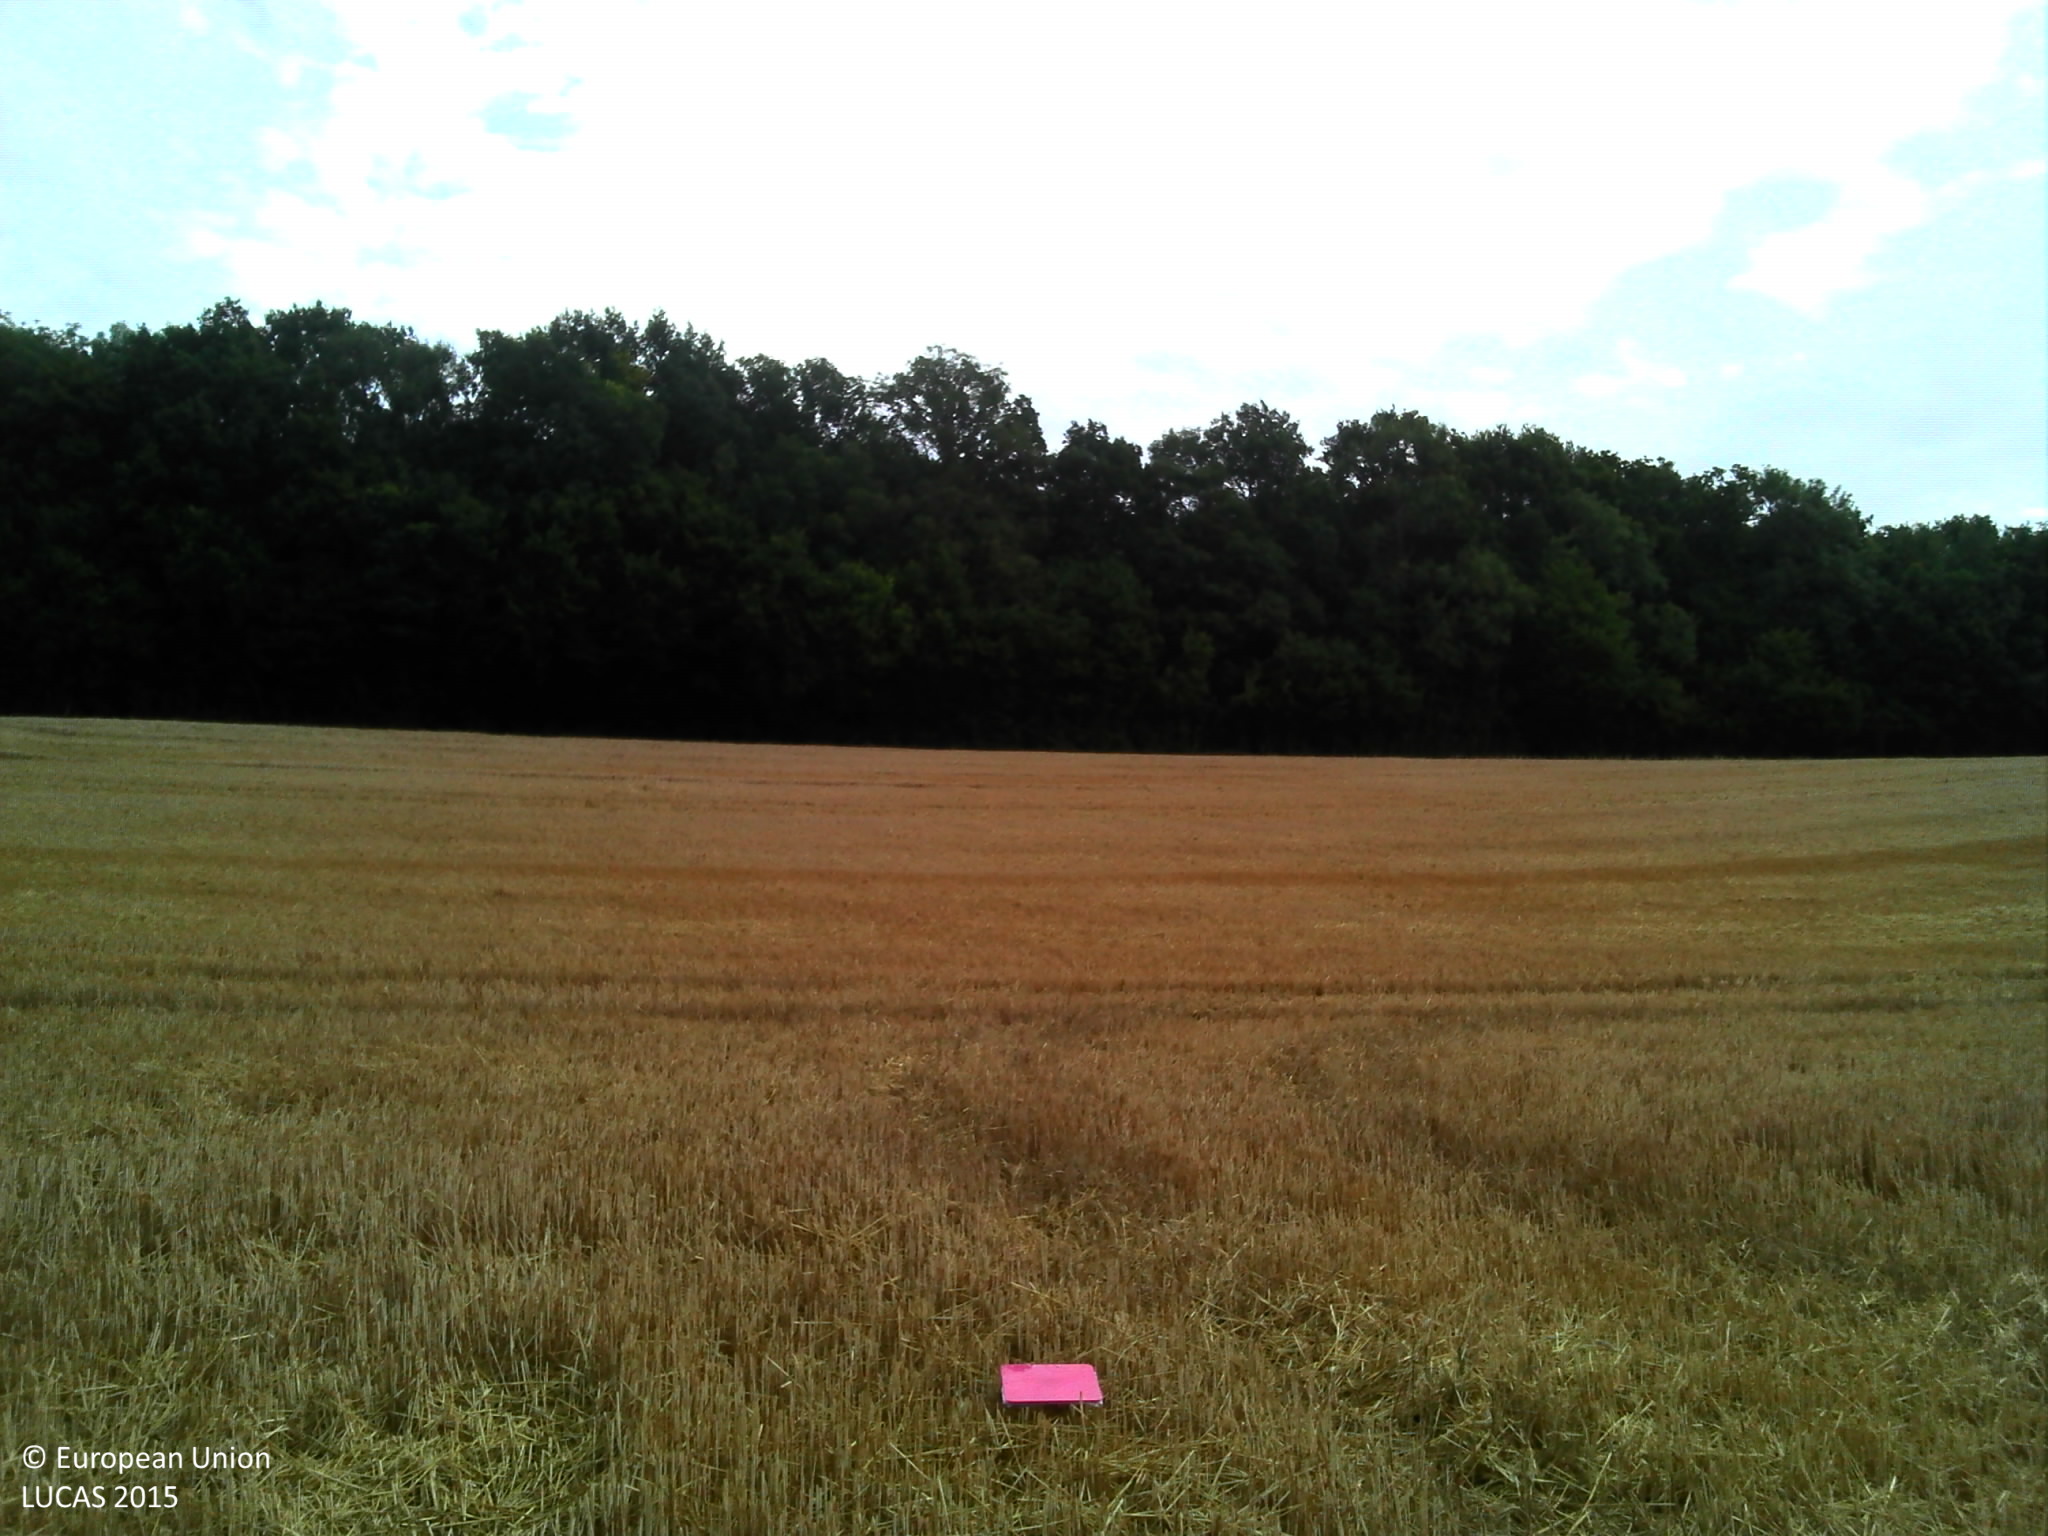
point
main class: Cropland
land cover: Common wheat
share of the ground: > 75 %
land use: Agriculture (excluding fallow land and kitchen gardens)
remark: Harvested field
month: July
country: FR
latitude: 49.1701
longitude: 2.9270
